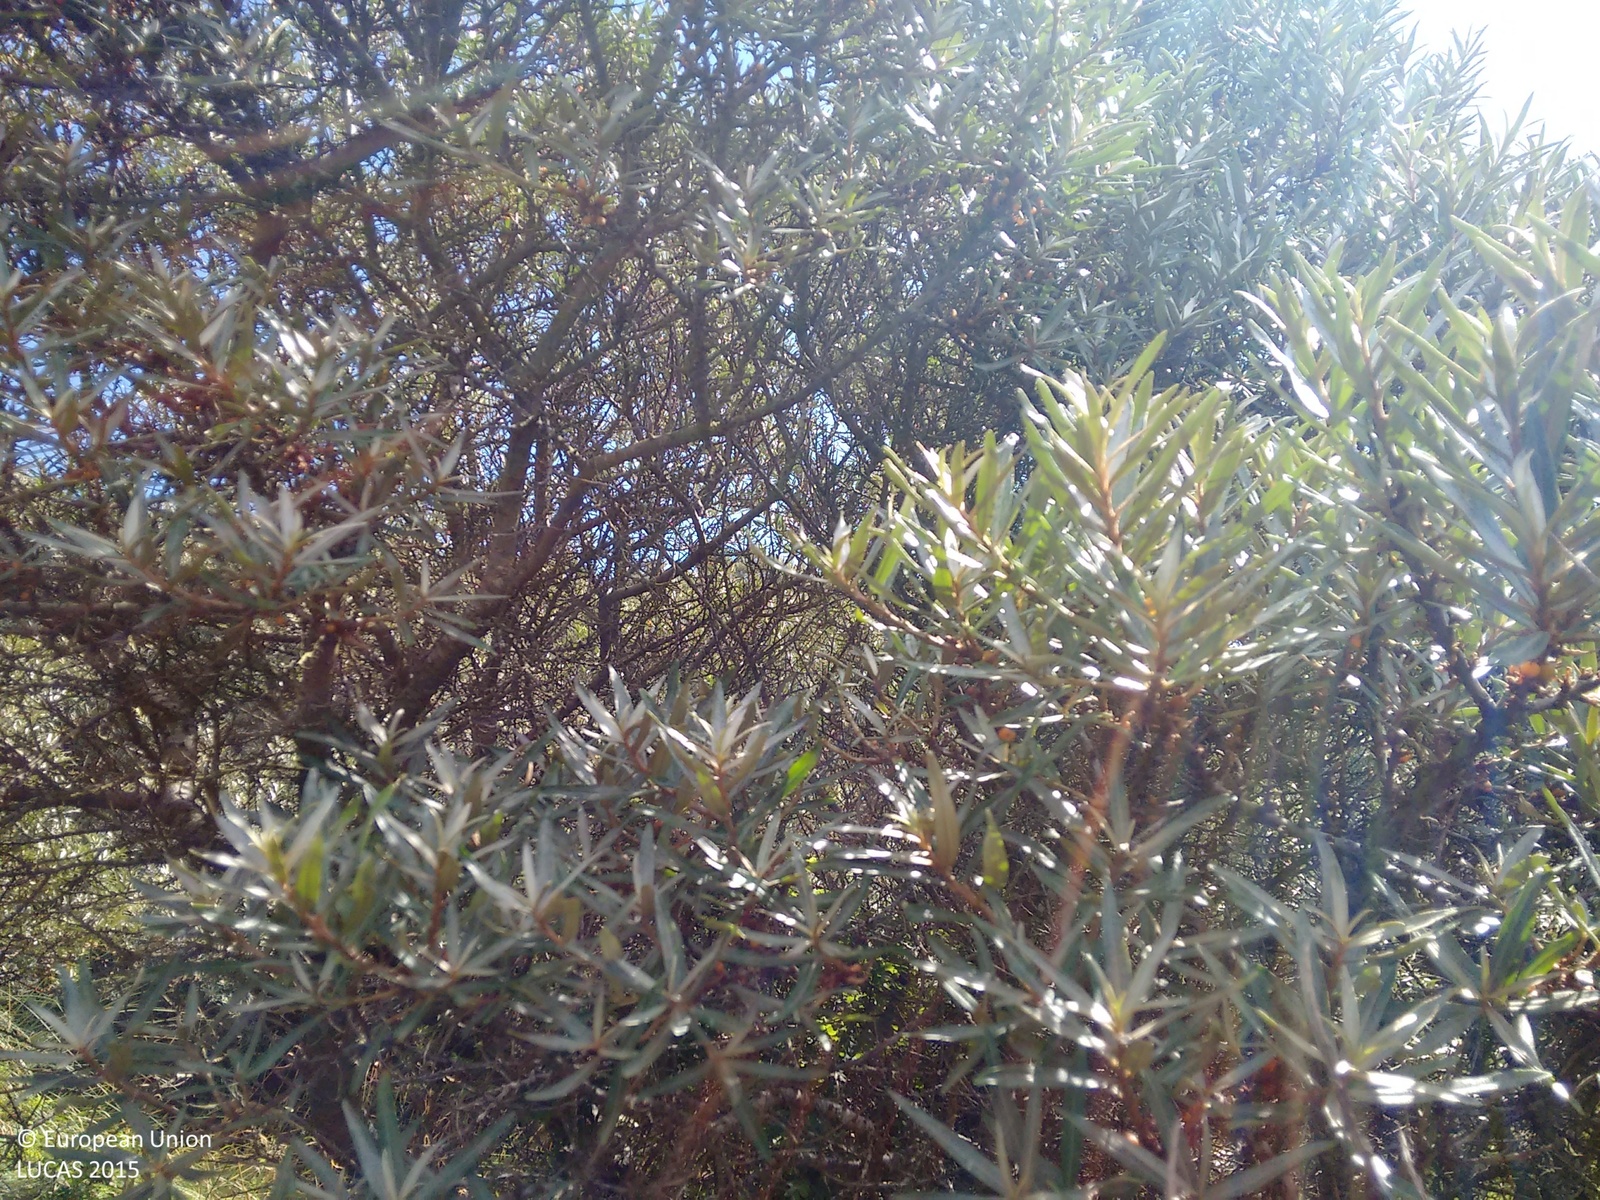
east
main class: Shrubland
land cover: Shrubland without tree cover
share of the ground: > 75 %
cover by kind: shrubs 95 %, herbaceous plants 5 %
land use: Semi-natural and natural areas not in use
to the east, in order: Shrubland without tree cover; Tracks; Shrubland without tree cover; Artificial constructions in urban areas; Shrubland without tree cover; Sand; Transitional water bodies
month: August
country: IE
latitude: 52.7075
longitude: -6.1770
